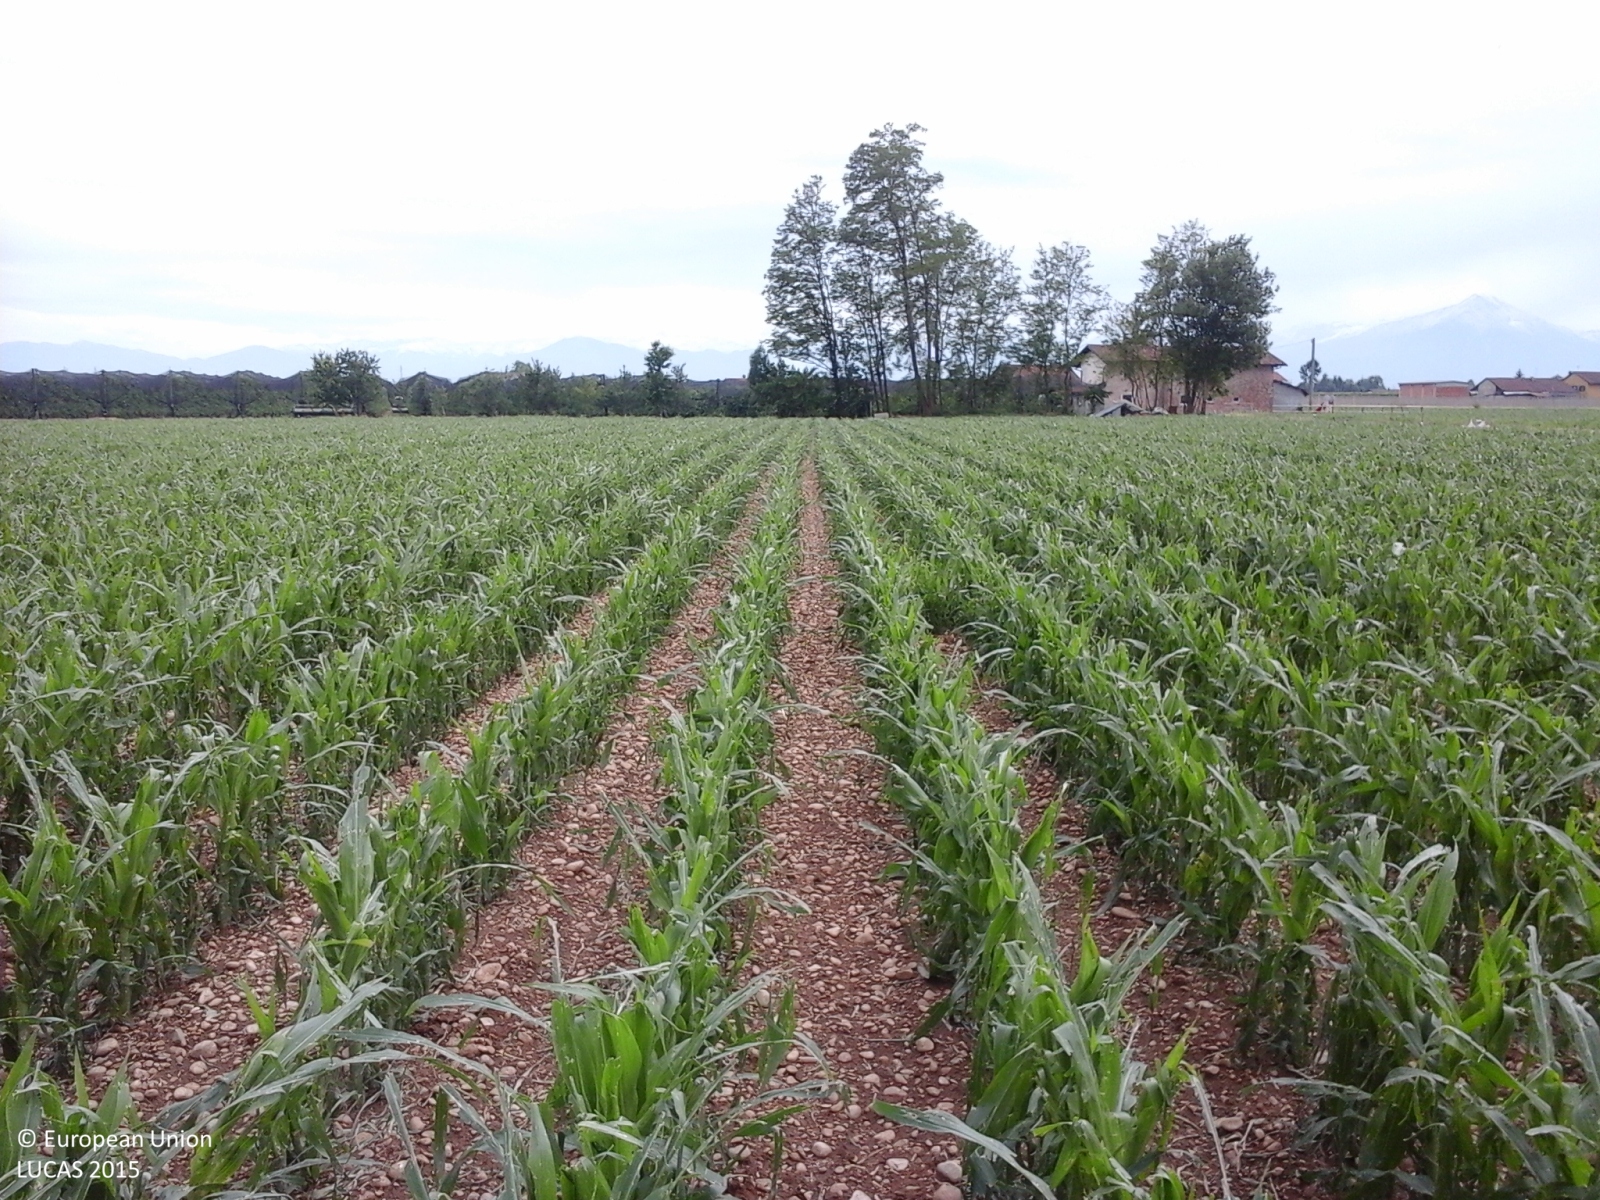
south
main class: Cropland
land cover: Maize
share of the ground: 25 - 50 %
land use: Agriculture (excluding fallow land and kitchen gardens)
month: May
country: IT
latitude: 44.5044
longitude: 7.6527
